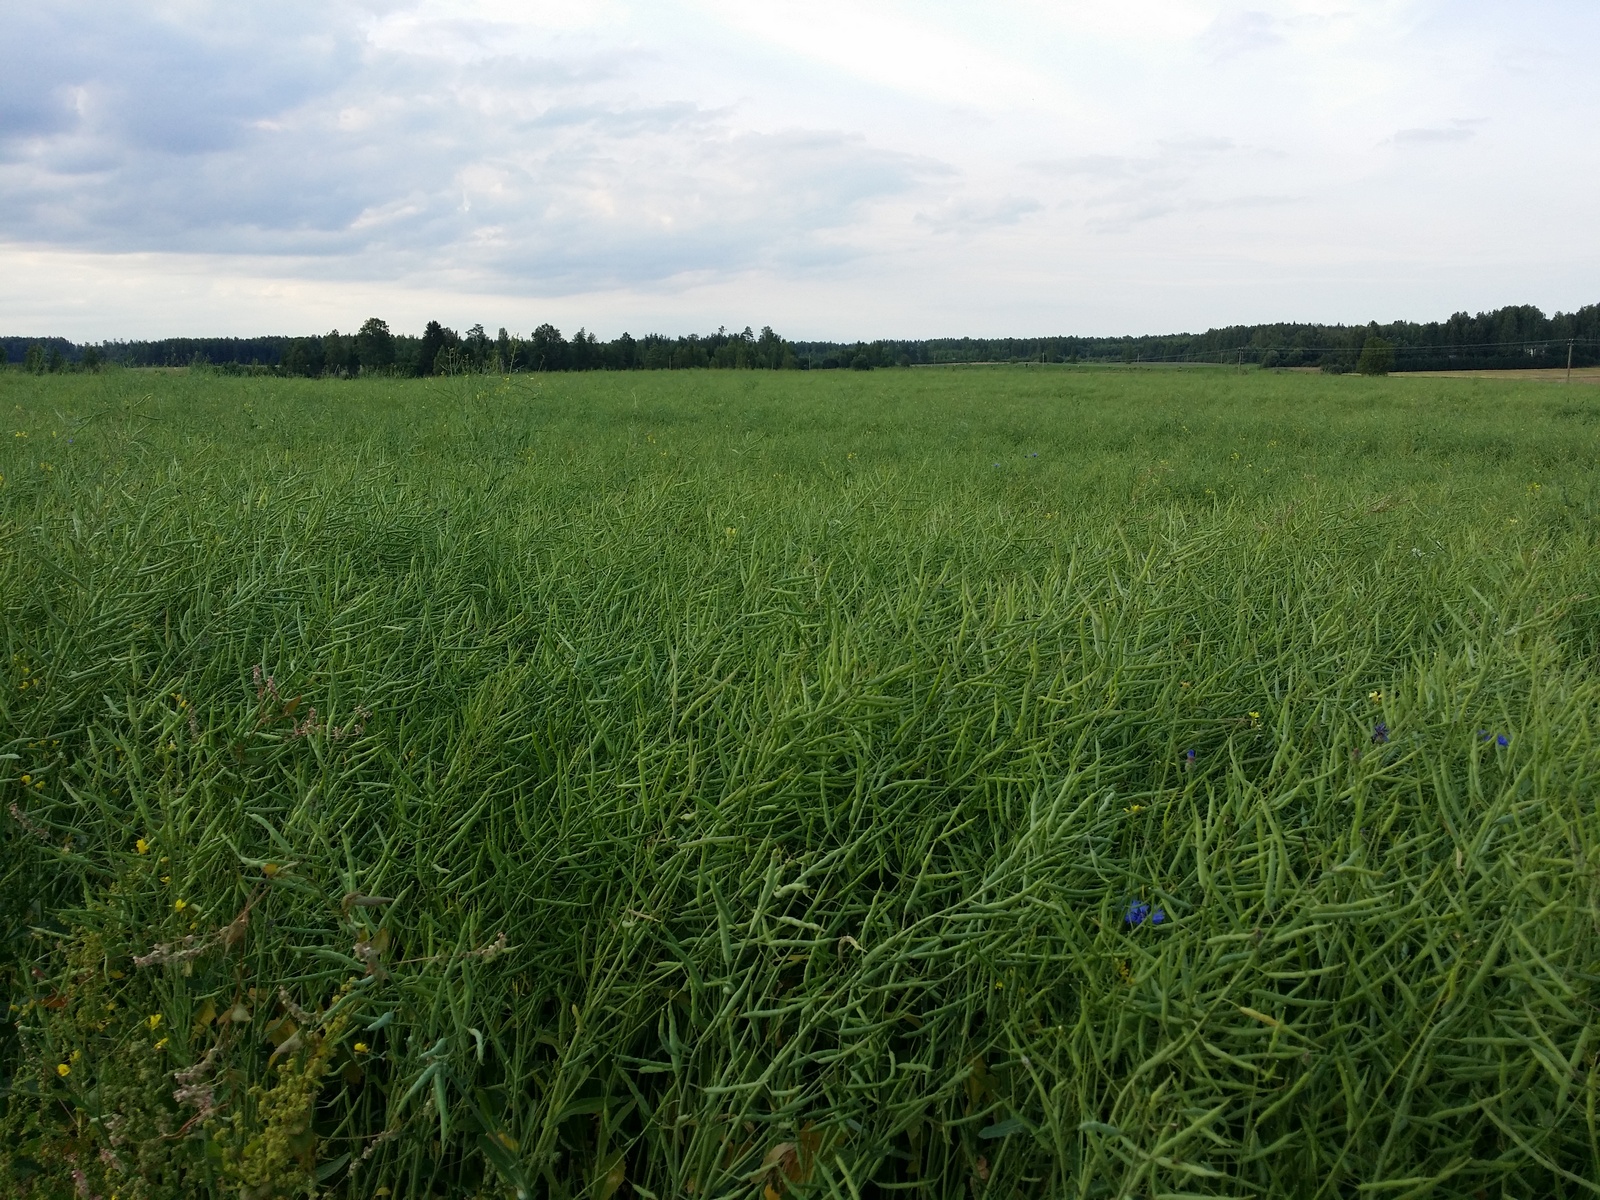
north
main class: Cropland
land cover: Rape and turnip rape
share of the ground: > 75 %
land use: Agriculture (excluding fallow land and kitchen gardens)
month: August
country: LV
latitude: 57.3749
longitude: 26.6278
